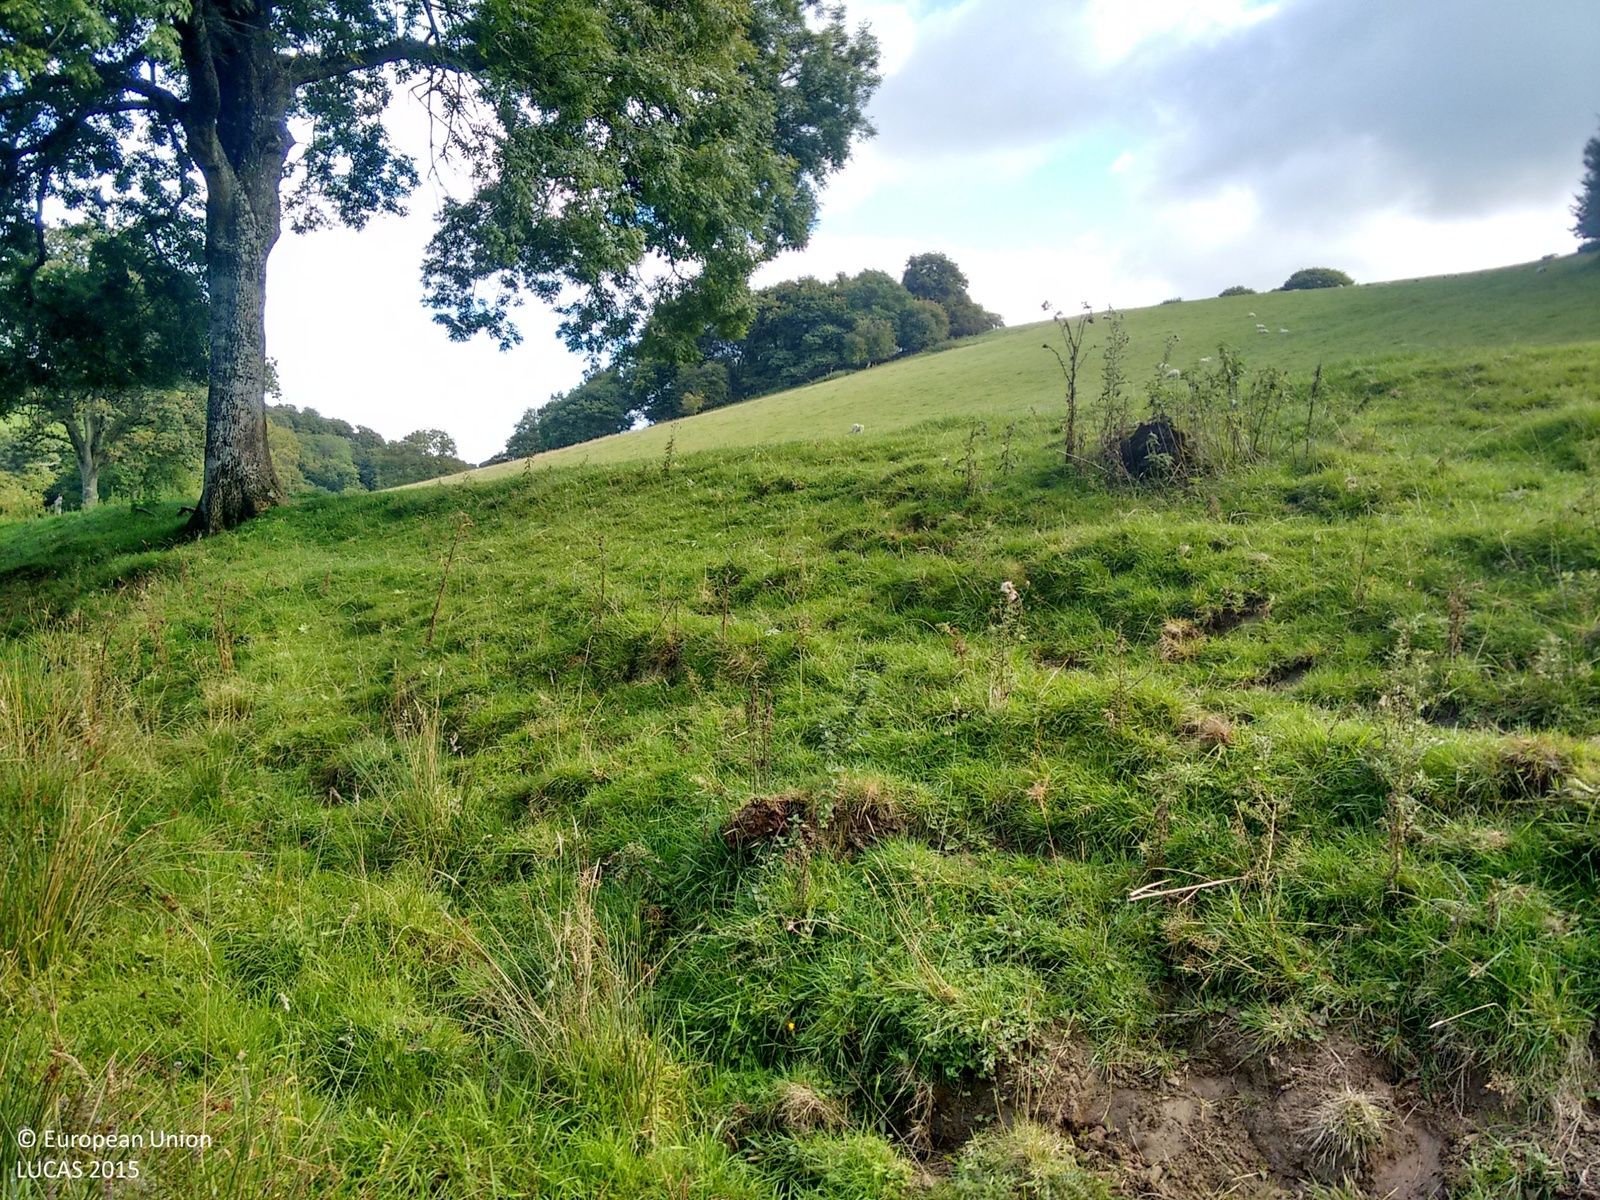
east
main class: Grassland
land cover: Grassland without tree/shrub cover
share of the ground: > 75 %
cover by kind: herbaceous plants 100 %
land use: Agriculture (excluding fallow land and kitchen gardens)
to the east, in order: Grassland without tree/shrub cover; Broadleaved woodland; Pine dominated coniferous woodland
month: September
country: GB
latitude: 52.5952
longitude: -3.2629
